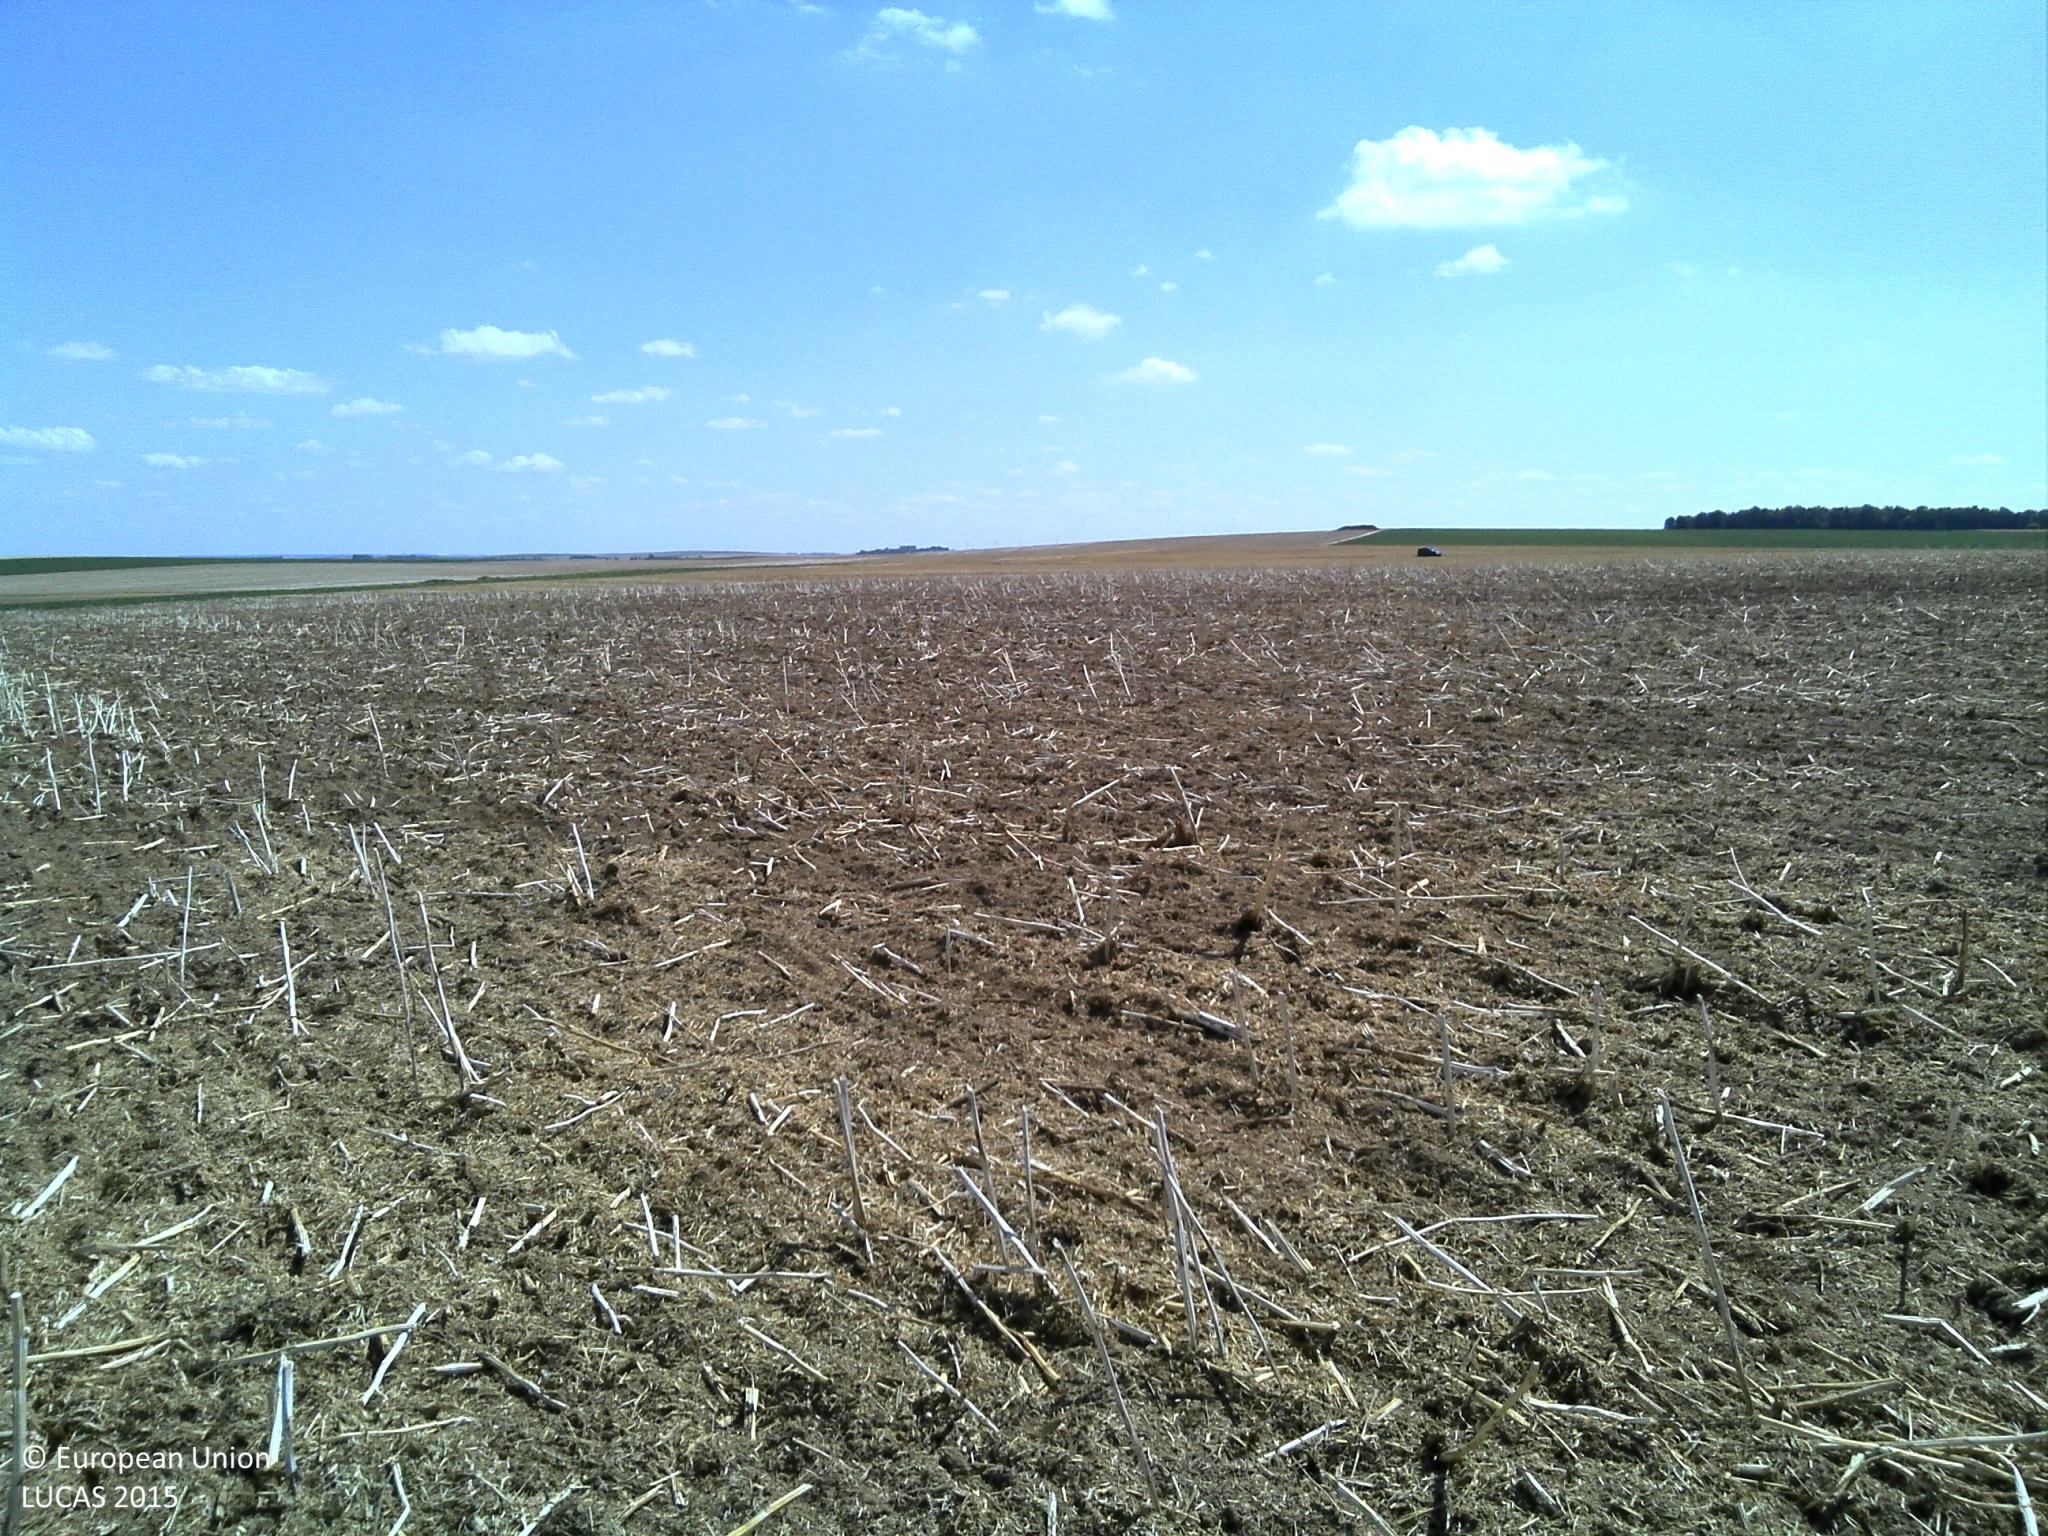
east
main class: Cropland
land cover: Rape and turnip rape
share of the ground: > 75 %
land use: Agriculture (excluding fallow land and kitchen gardens)
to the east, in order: Rape and turnip rape
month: August
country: FR
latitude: 49.0133
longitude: 4.6511
